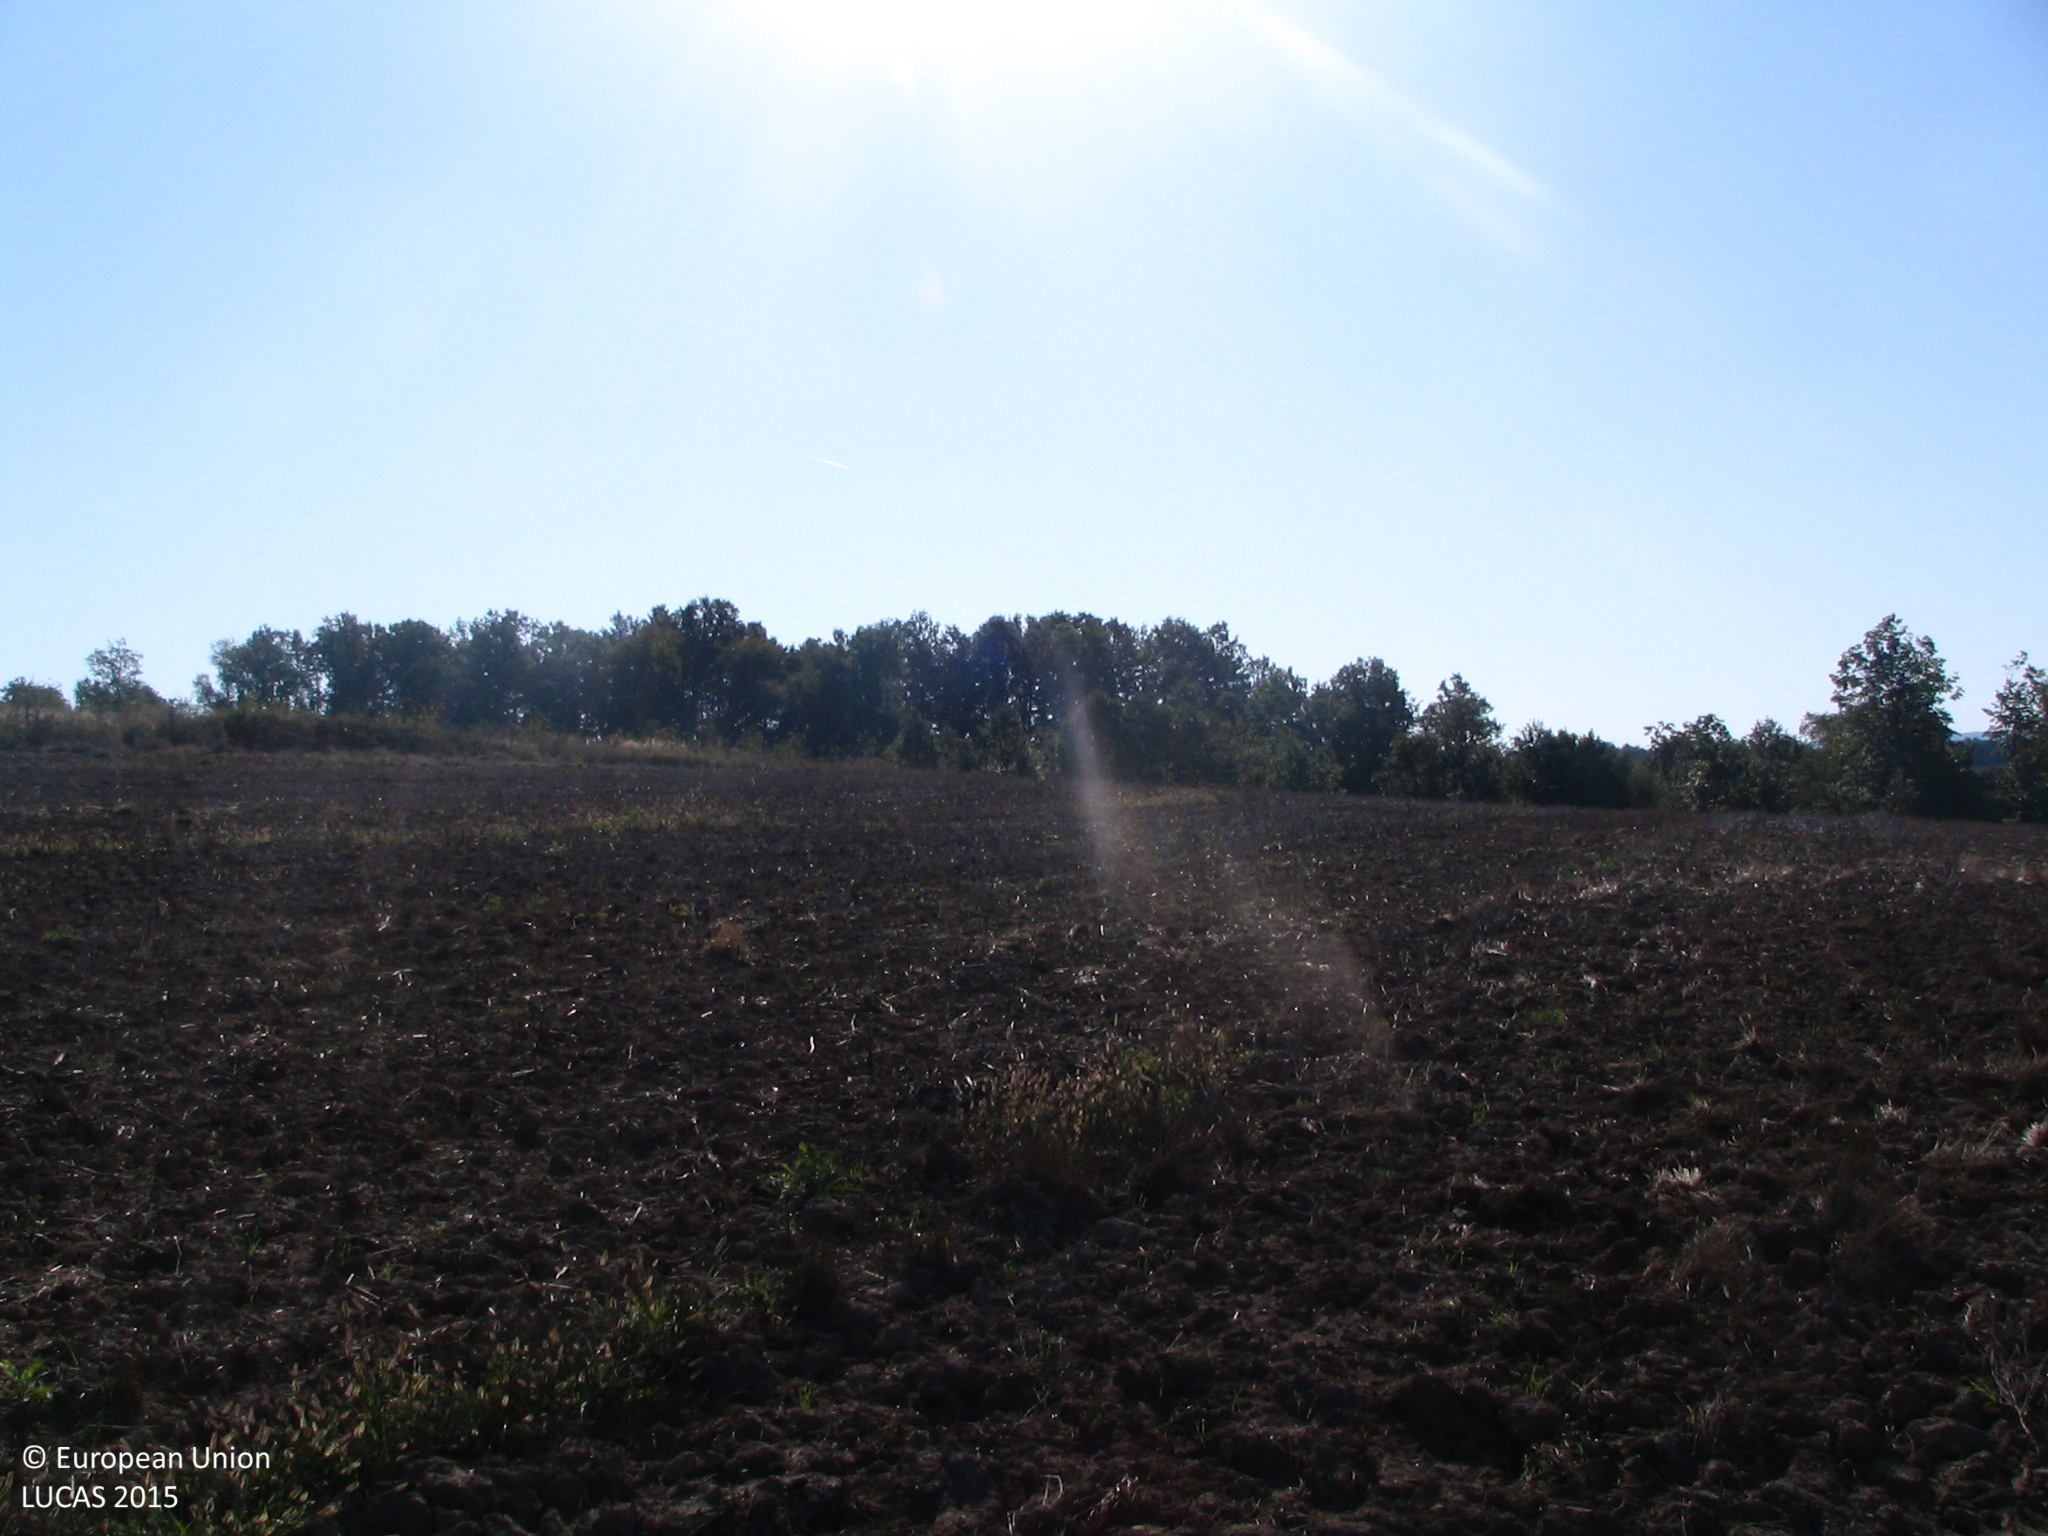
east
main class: Cropland
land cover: Common wheat
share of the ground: < 10 %
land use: Agriculture (excluding fallow land and kitchen gardens)
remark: Harvested field
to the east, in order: Common wheat; Grass margins; Fences; Nuts trees; Fences; Grassland with sparse tree/shrub cover; Broadleaved woodland
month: August
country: BG
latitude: 43.0748
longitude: 24.4629
